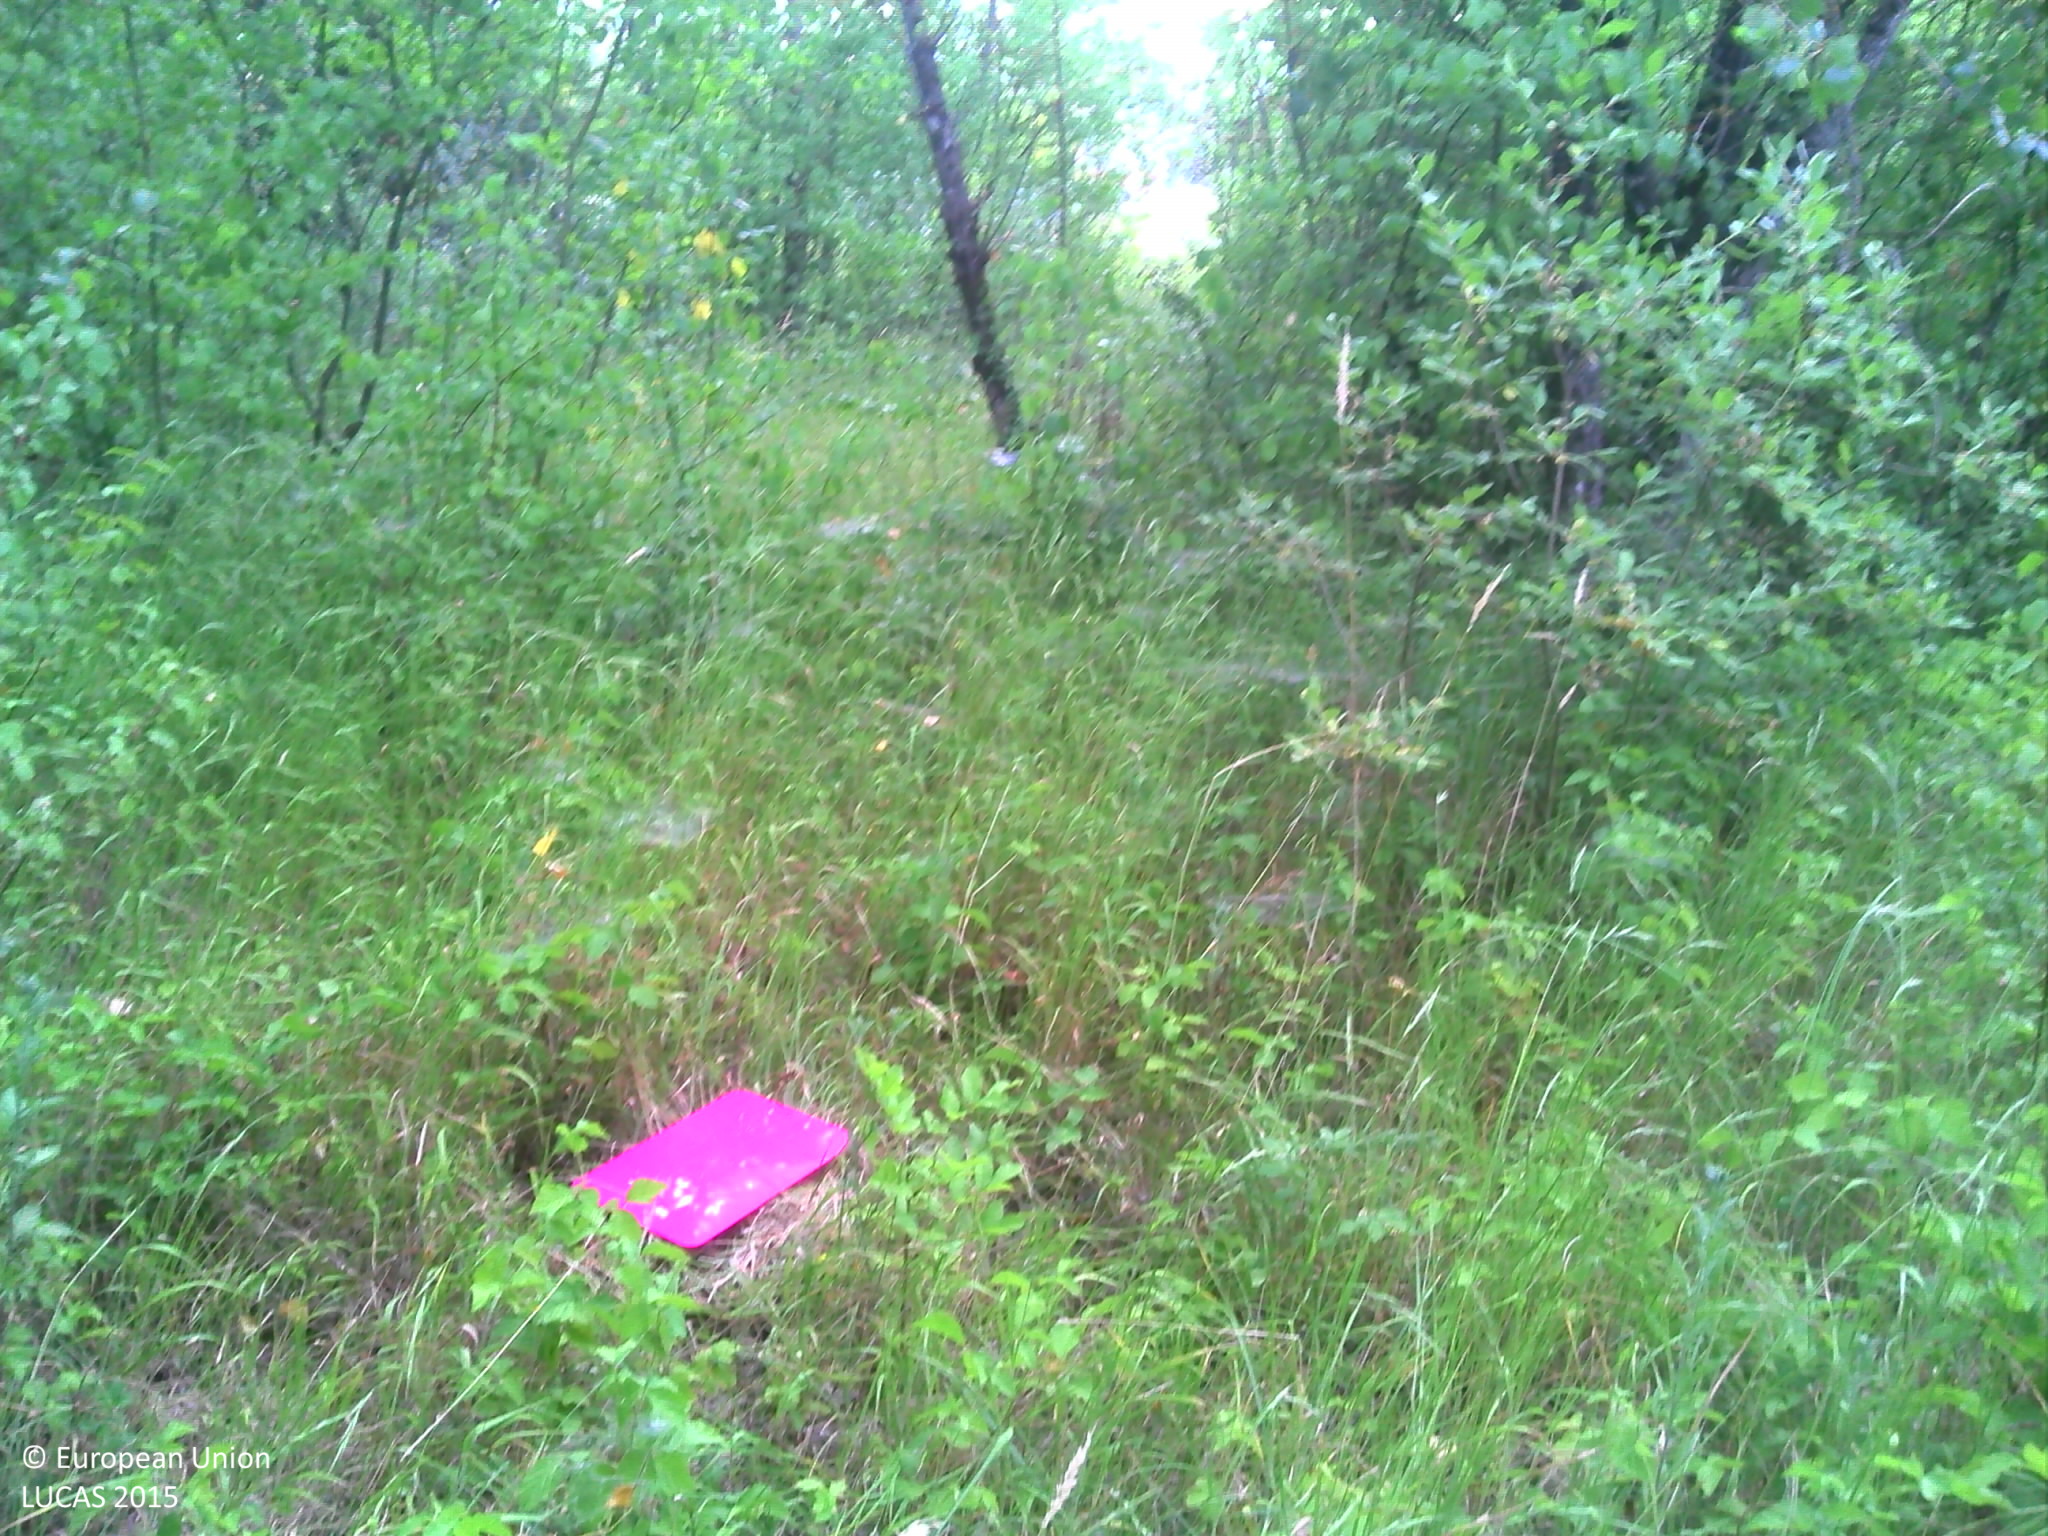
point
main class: Woodland
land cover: Broadleaved woodland
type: beech forest
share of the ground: > 75 %
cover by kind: broadleaved forest trees 60 %, herbaceous plants 30 %, lichens and mosses 10 %
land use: Semi-natural and natural areas not in use
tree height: > 5 m
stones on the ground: < 10 %
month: July
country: FR
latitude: 46.1435
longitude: 6.3140
